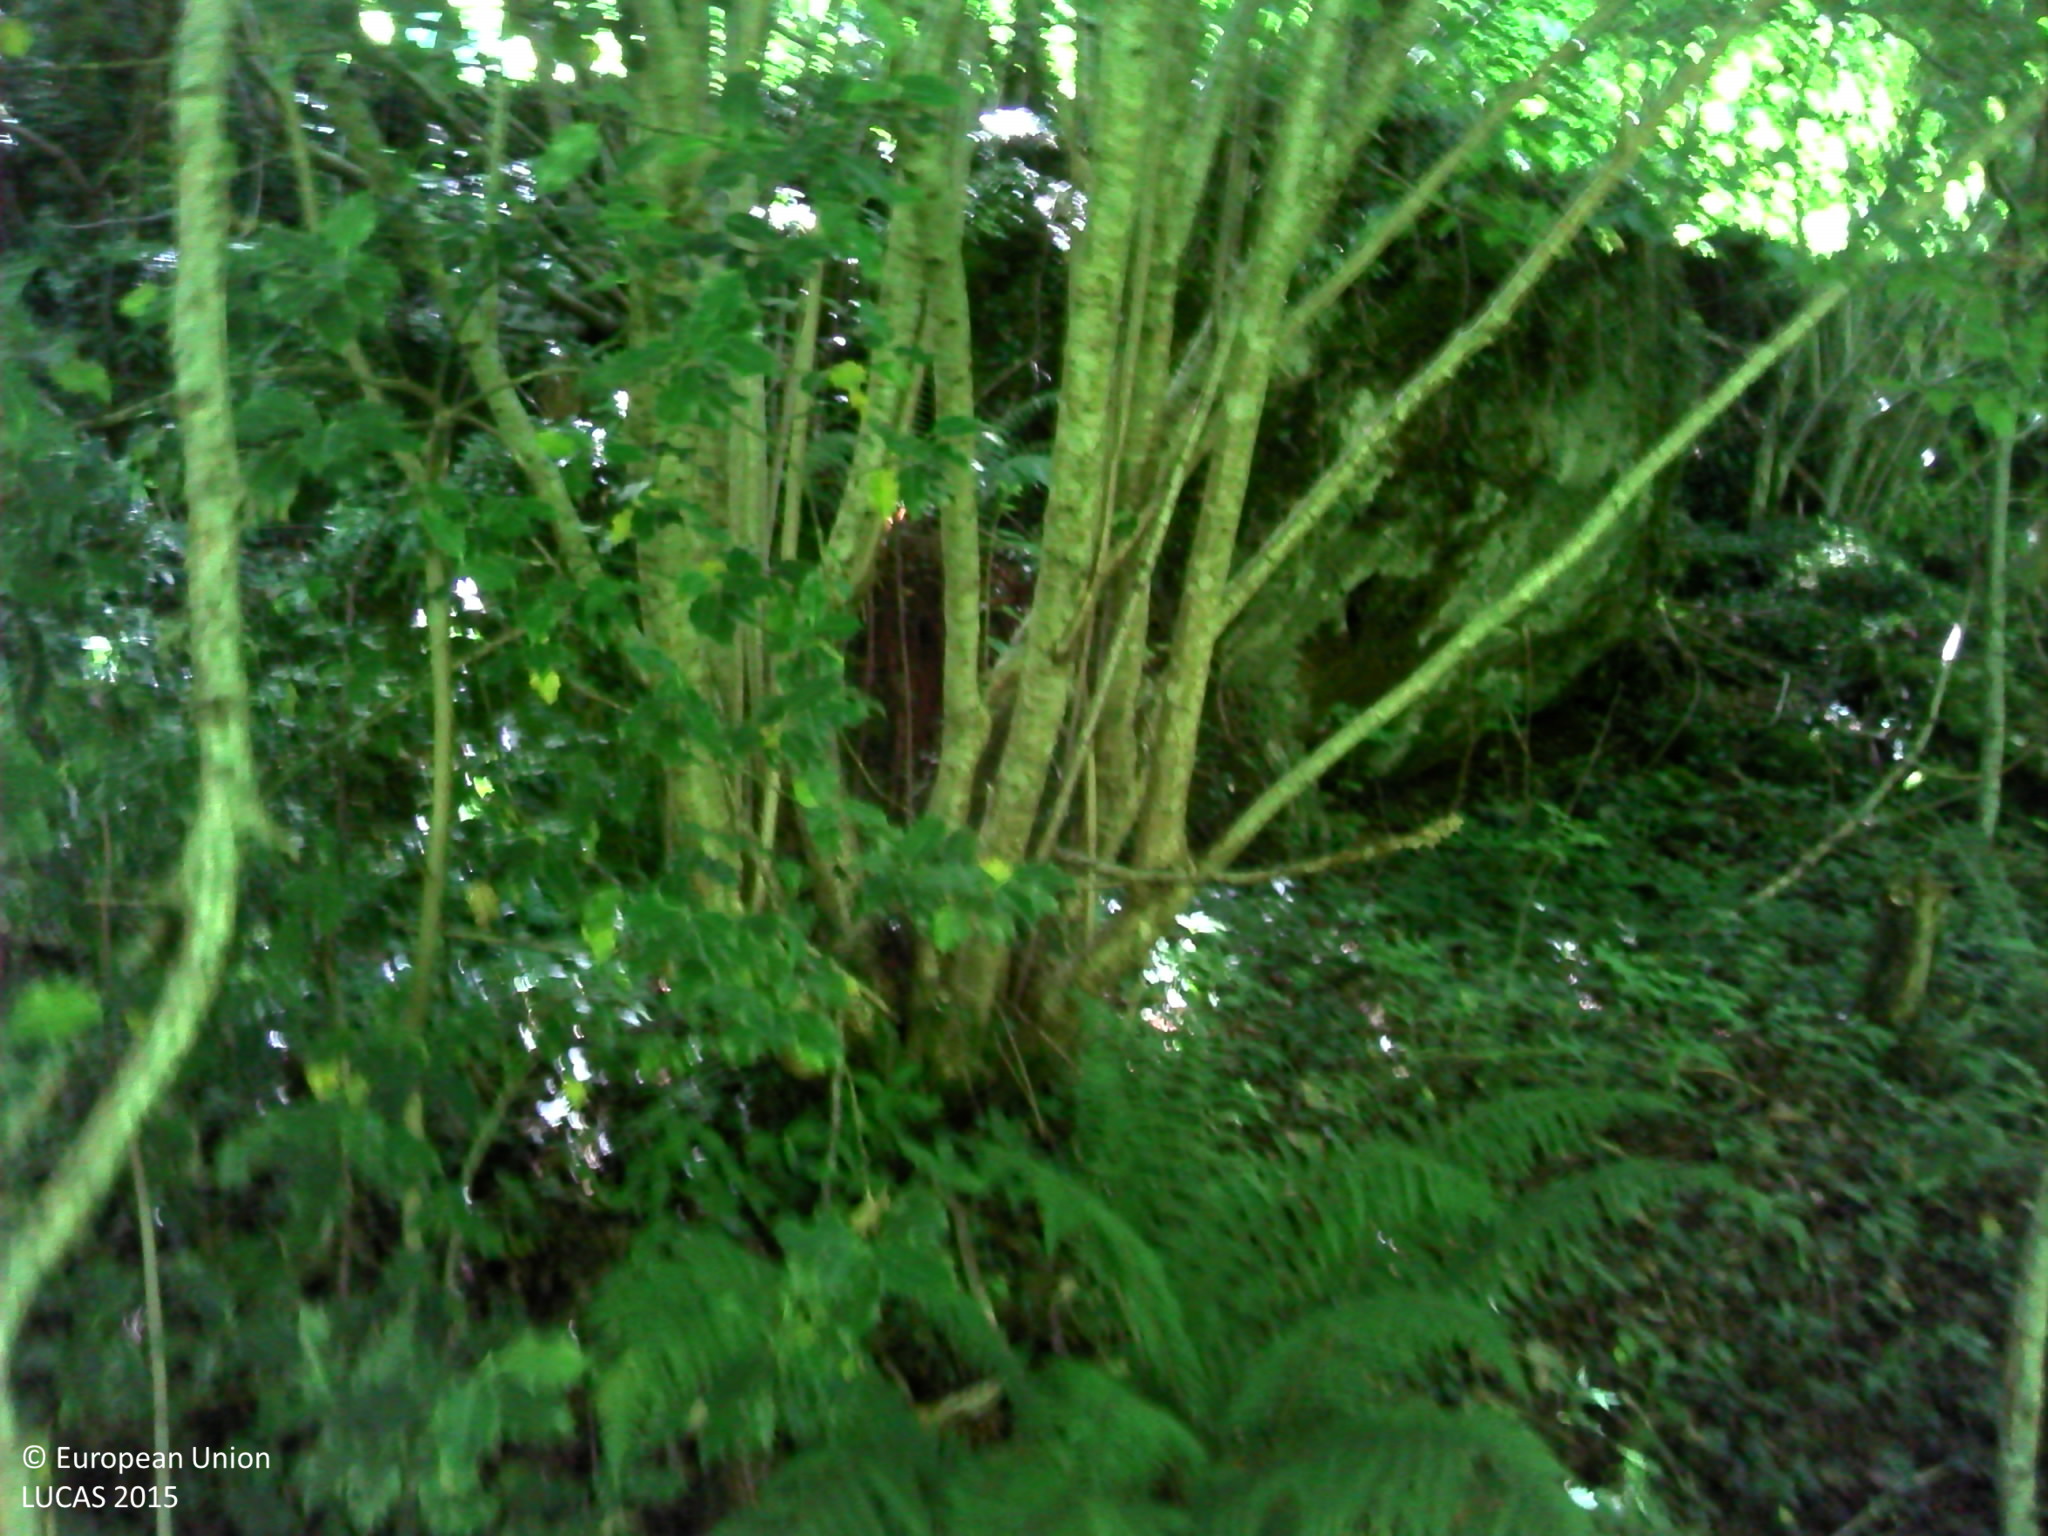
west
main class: Woodland
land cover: Broadleaved woodland
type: mesophytic deciduous forest
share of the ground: > 75 %
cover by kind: broadleaved forest trees 50 %, consolidated bare surface 30 %, shrubs 10 %, herbaceous plants 10 %
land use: Forestry
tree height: > 5 m
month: July
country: FR
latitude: 42.9695
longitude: 0.8940
